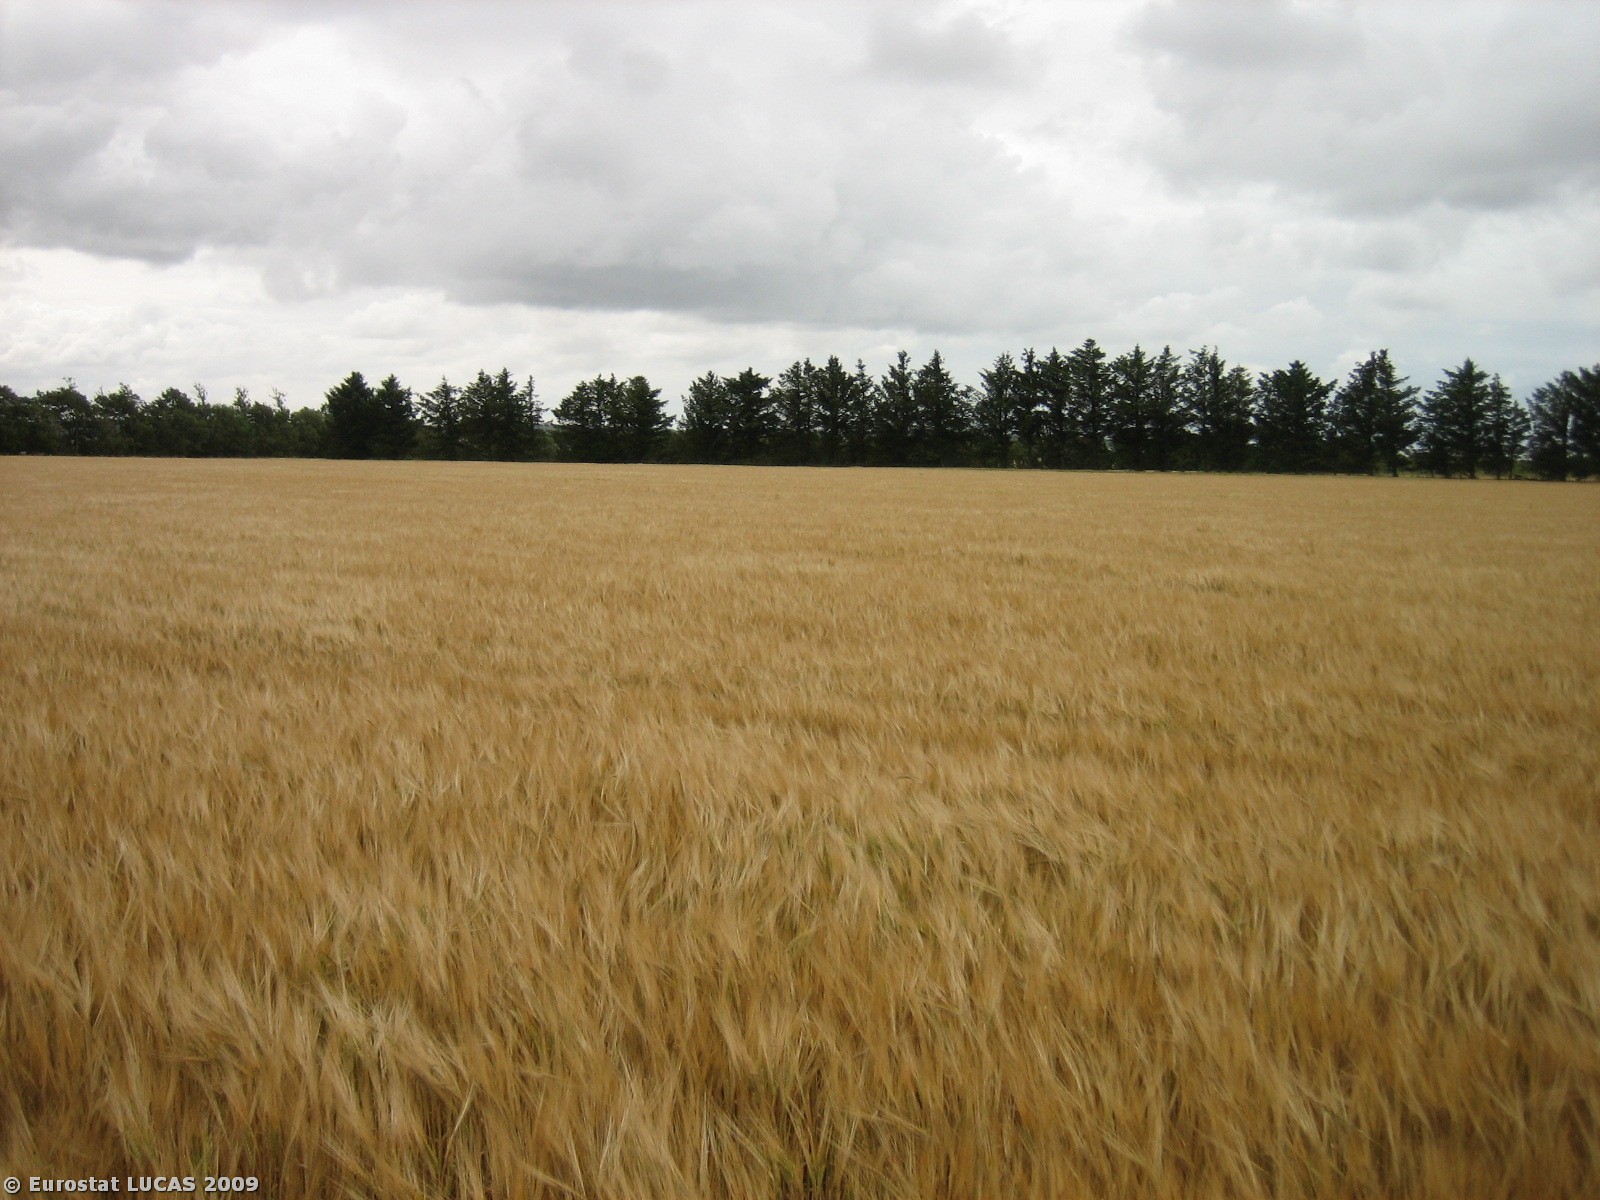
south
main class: Cropland
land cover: Barley
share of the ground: > 75 %
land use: Agriculture (excluding fallow land and kitchen gardens)
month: July
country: DK
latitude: 55.6012
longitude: 8.3033
